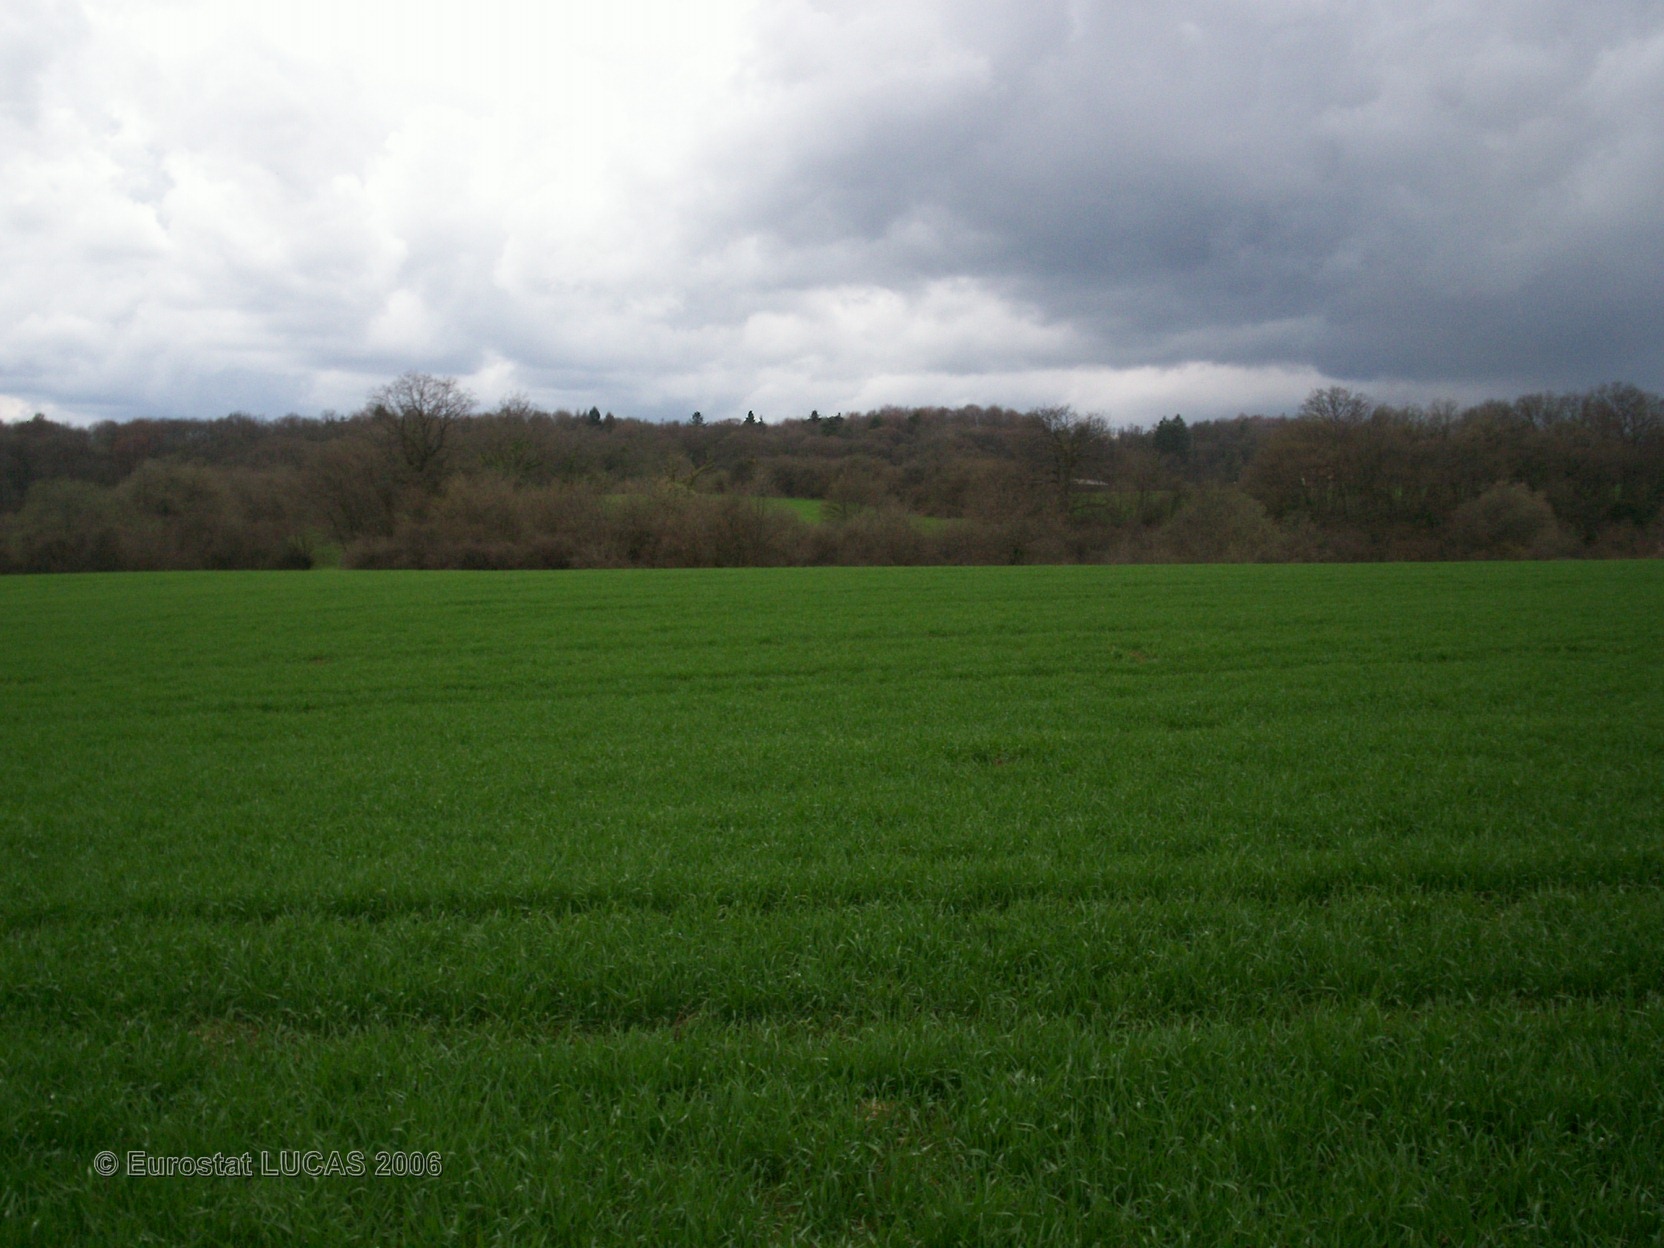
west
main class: Cropland
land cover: Common wheat
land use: Agriculture (excluding fallow land and kitchen gardens)
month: April
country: FR
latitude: 47.5043
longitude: 6.5896
